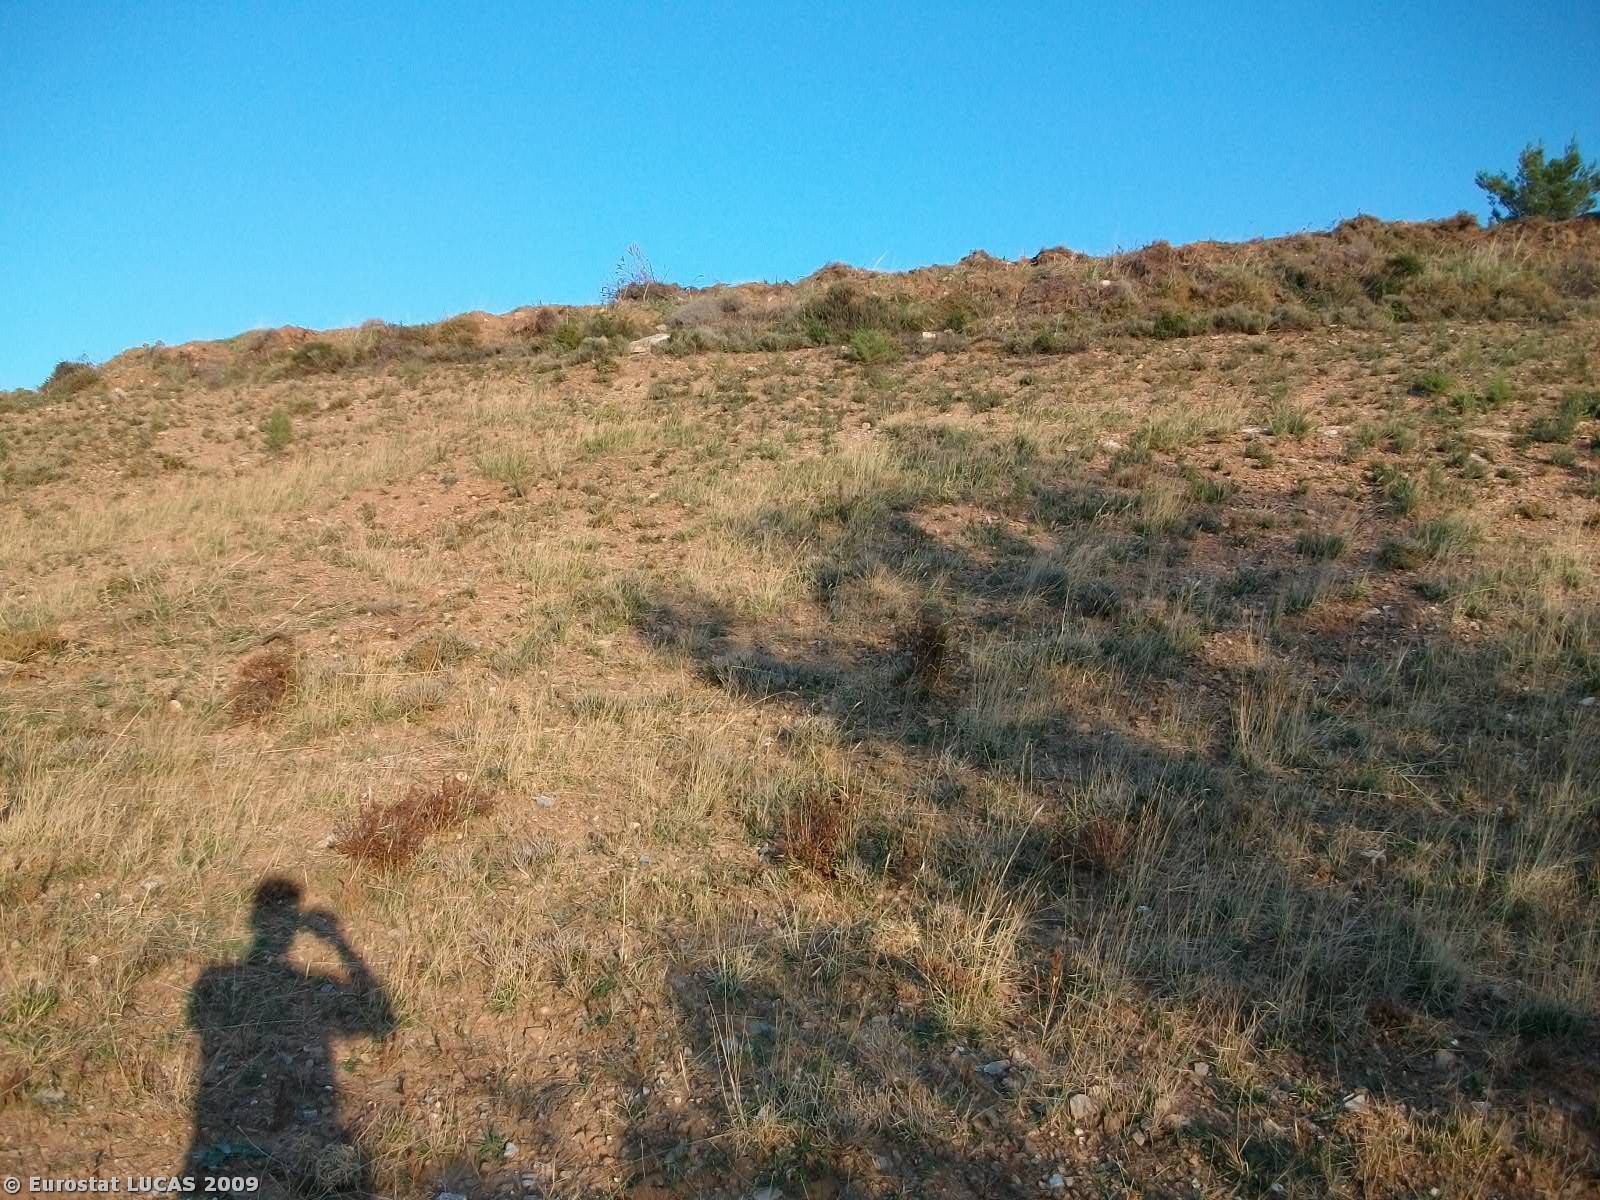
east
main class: Grassland
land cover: Grassland with sparse tree/shrub cover
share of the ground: > 75 %
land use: Unused
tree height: > 5 m
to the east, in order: Grassland with sparse tree/shrub cover; Coniferous woodland; Grassland without tree/shrub cover; Paved roads, cycling and walking lanes; Grassland with sparse tree/shrub cover
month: September
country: GR
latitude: 38.2367
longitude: 23.9594
